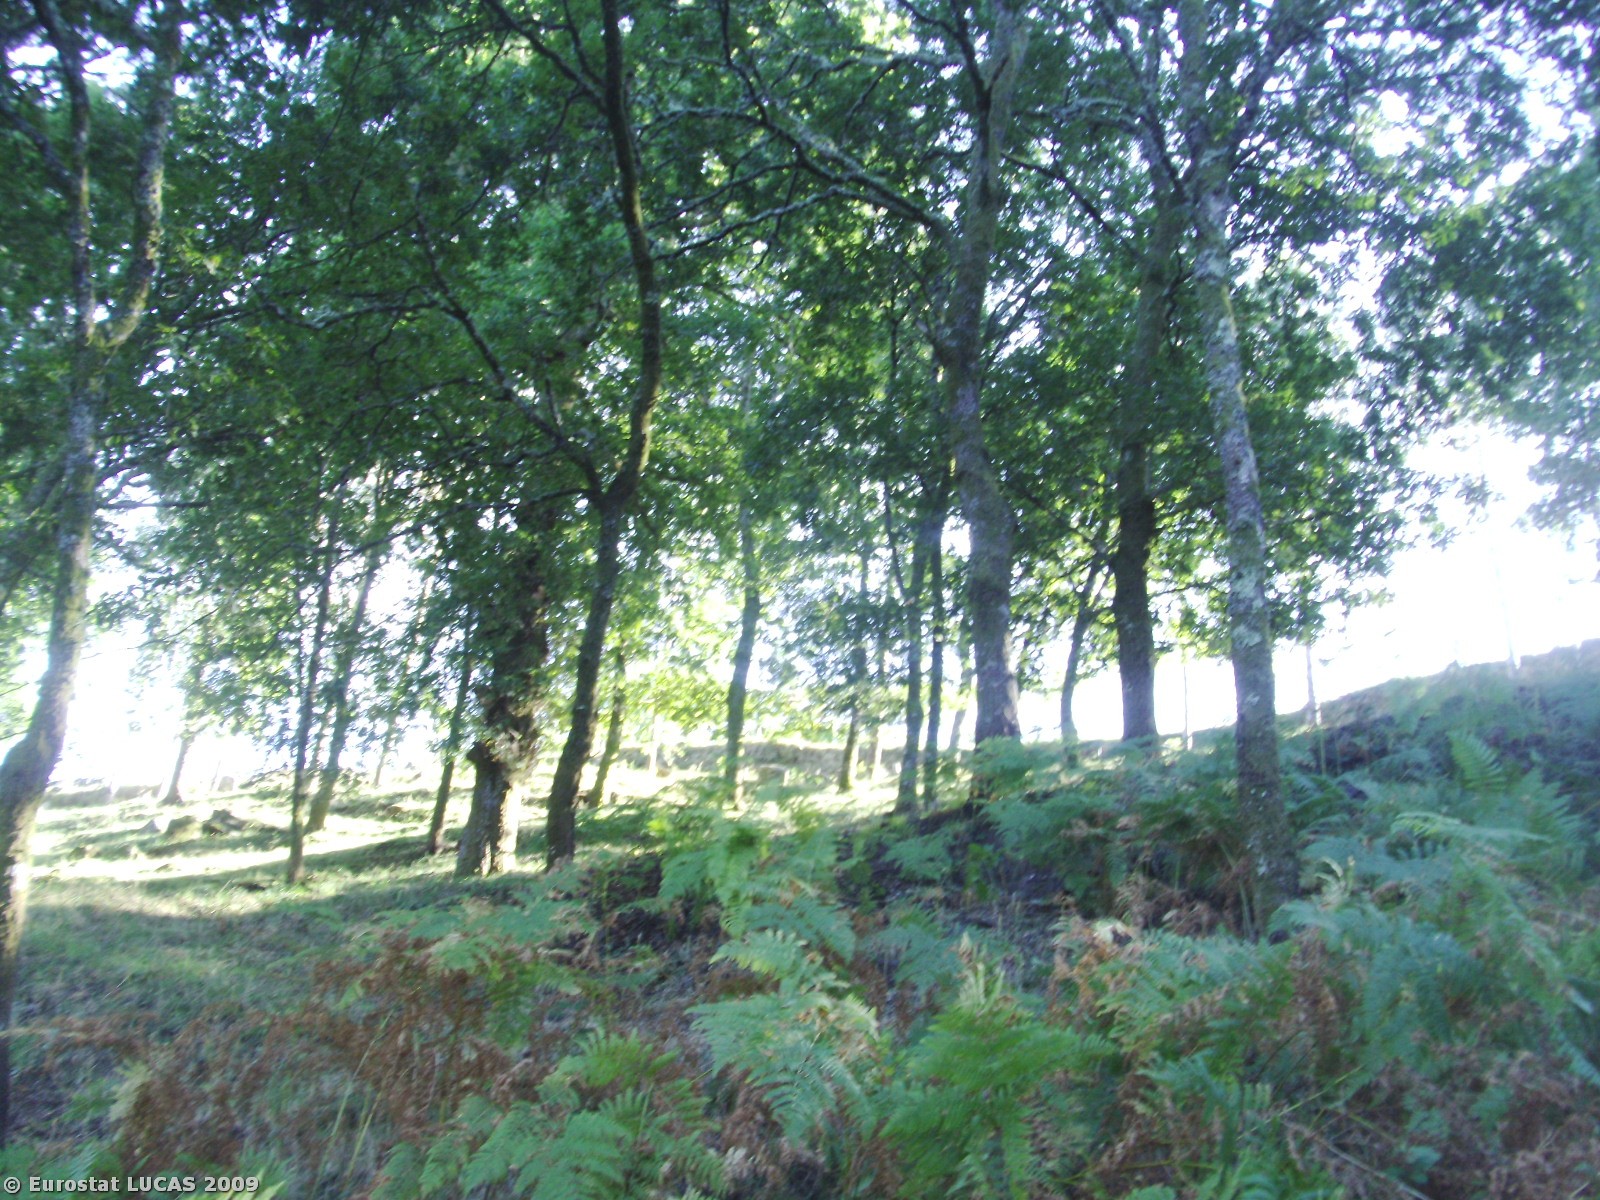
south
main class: Woodland
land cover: Broadleaved woodland
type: acidophilous oak and oak-birch forest
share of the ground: > 75 %
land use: Forestry
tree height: > 5 m
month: September
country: PT
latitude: 41.6667
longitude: -8.0276
